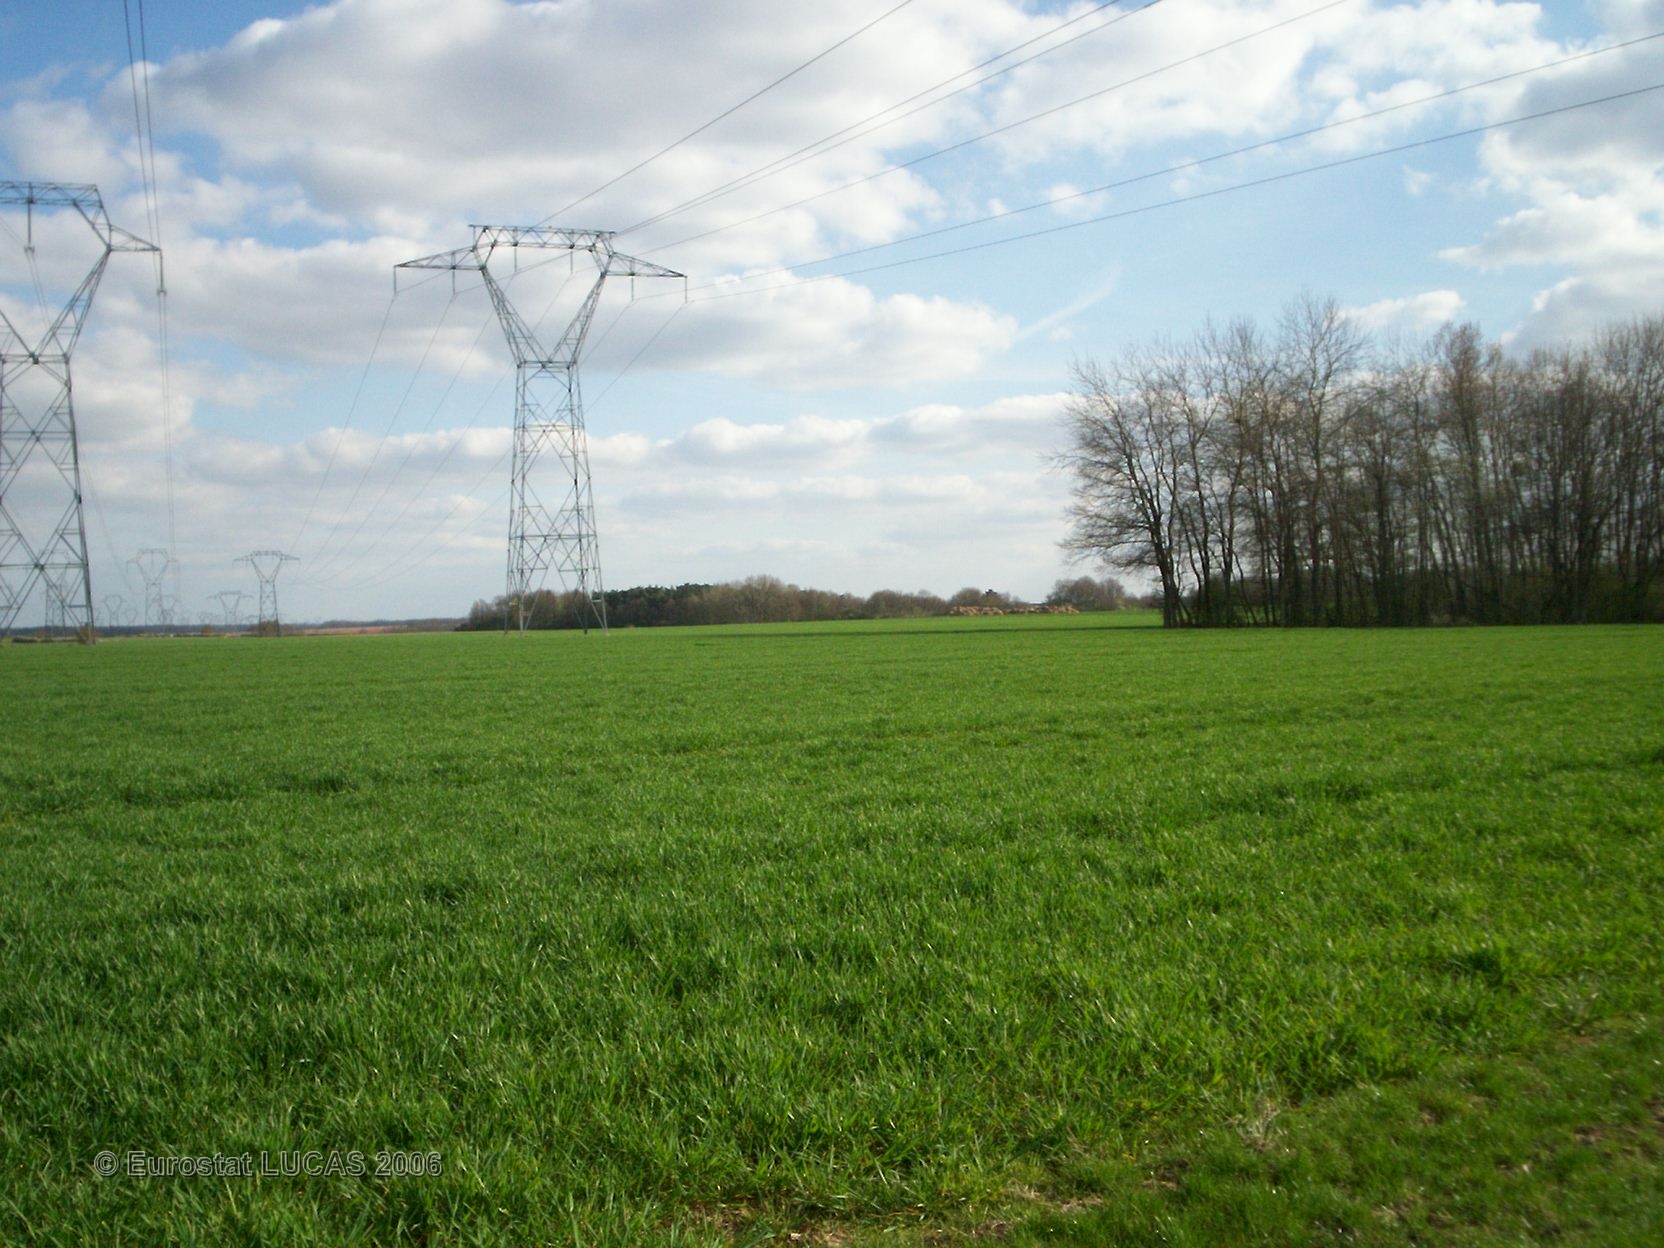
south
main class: Cropland
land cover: Maize
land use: Agriculture (excluding fallow land and kitchen gardens)
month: May
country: FR
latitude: 48.4780
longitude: 2.8349
